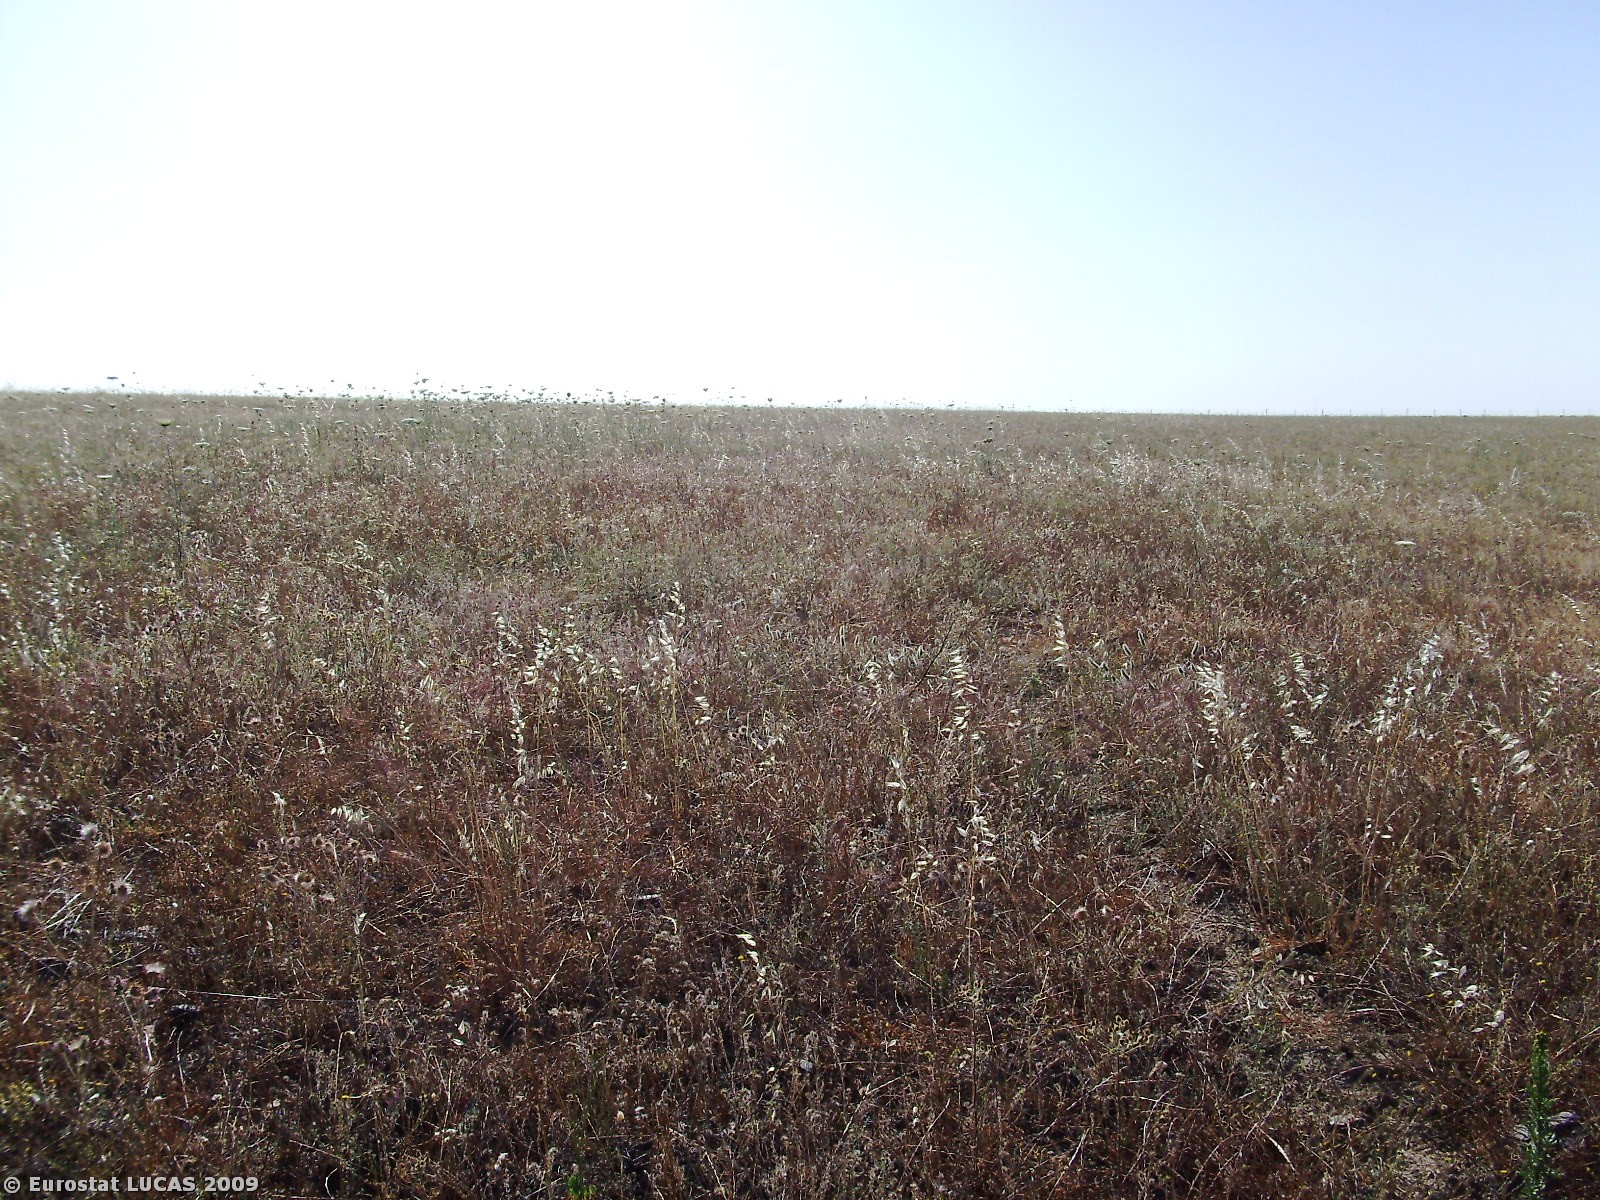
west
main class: Grassland
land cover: Spontaneously vegetated surfaces
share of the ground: > 75 %
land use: Fallow land
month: May
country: PT
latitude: 38.9587
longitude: -7.1899
